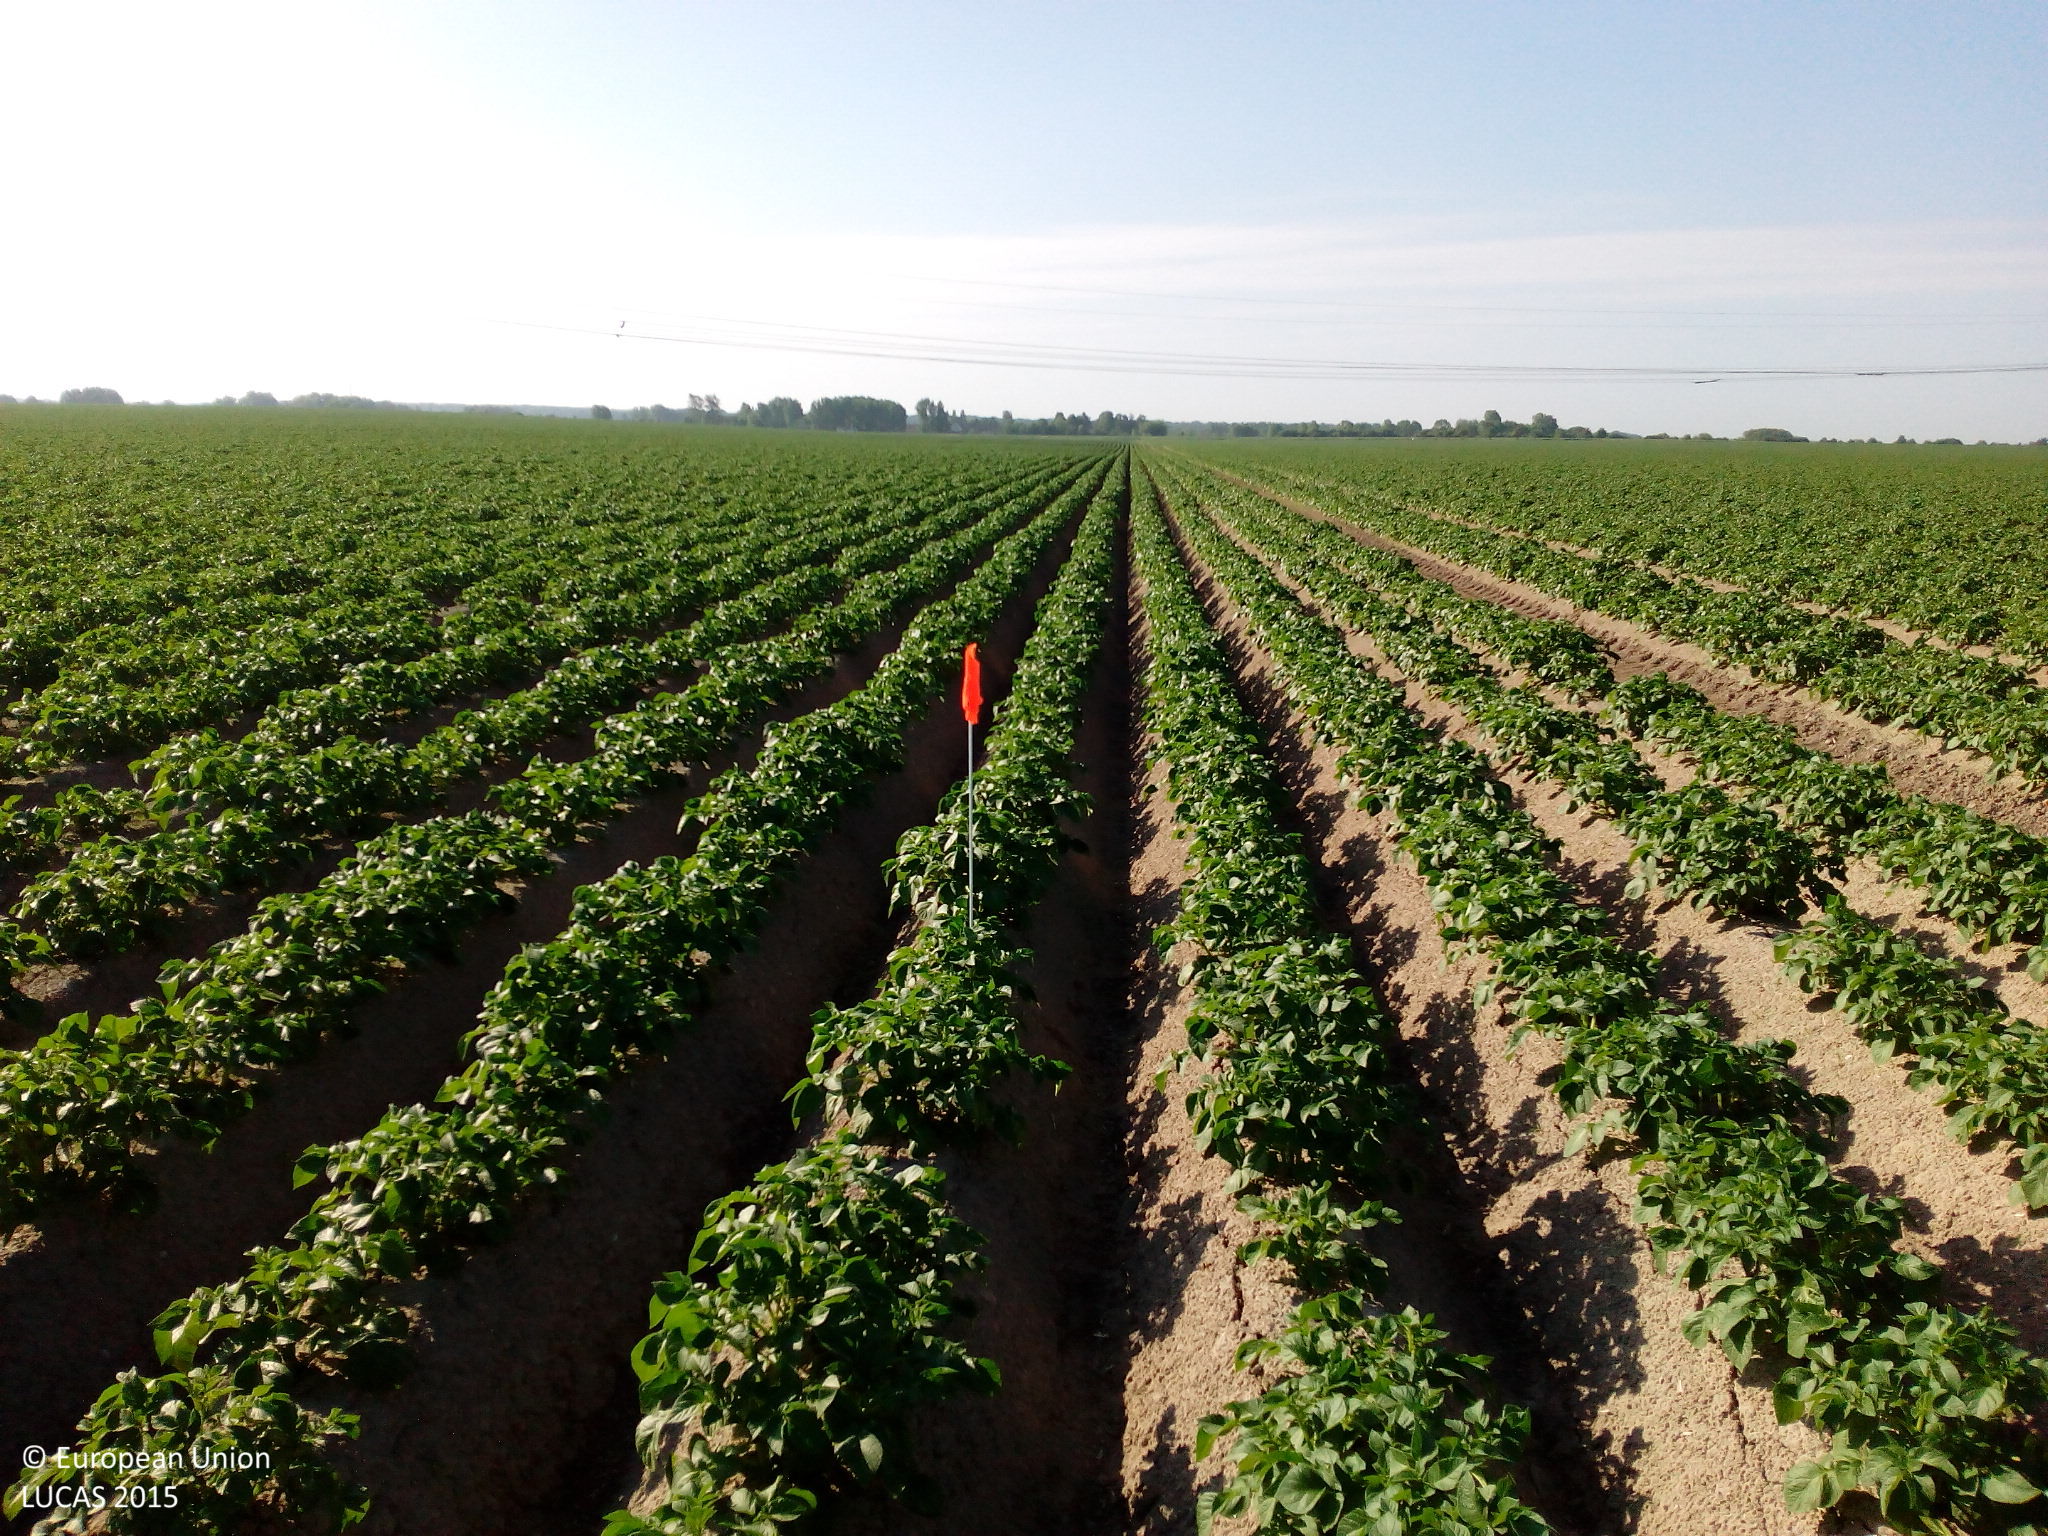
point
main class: Cropland
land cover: Potatoes
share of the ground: 50 - 75 %
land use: Agriculture (excluding fallow land and kitchen gardens)
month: June
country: DE
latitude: 51.0557
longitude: 12.5250
